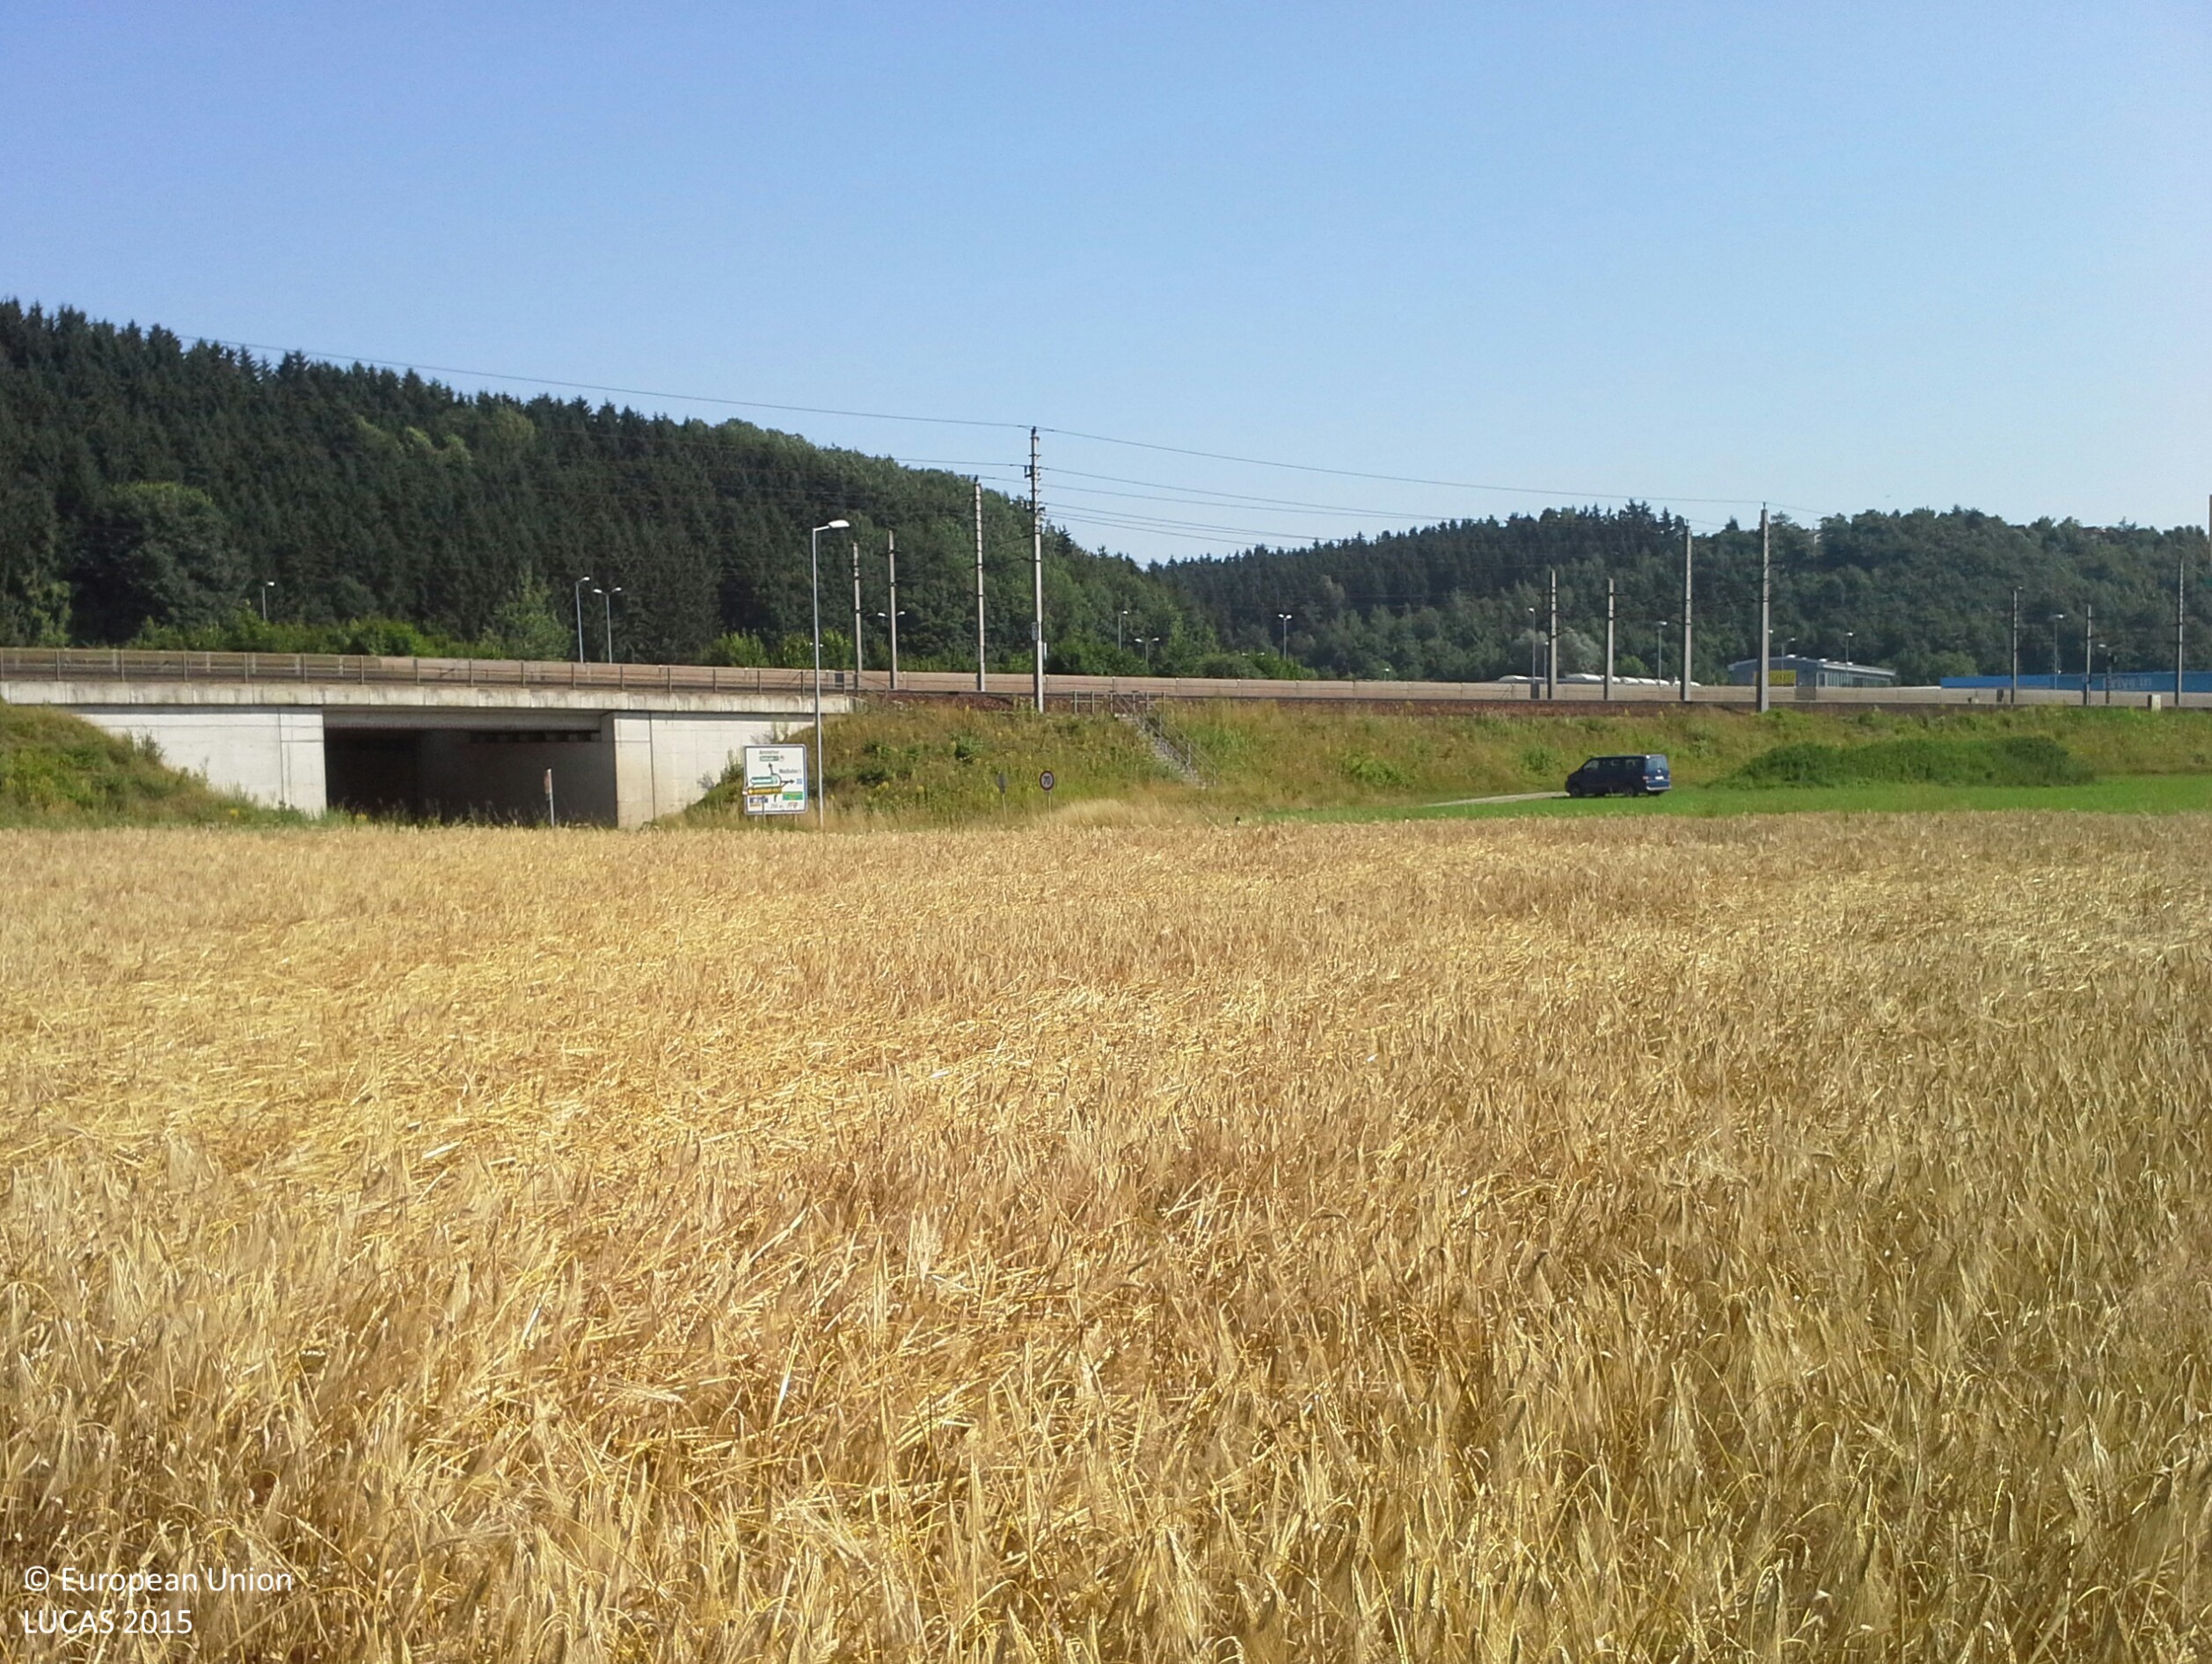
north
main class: Cropland
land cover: Barley
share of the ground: > 75 %
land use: Agriculture (excluding fallow land and kitchen gardens)
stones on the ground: 25 - 50 %
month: July
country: AT
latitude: 48.1168
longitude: 14.8500
